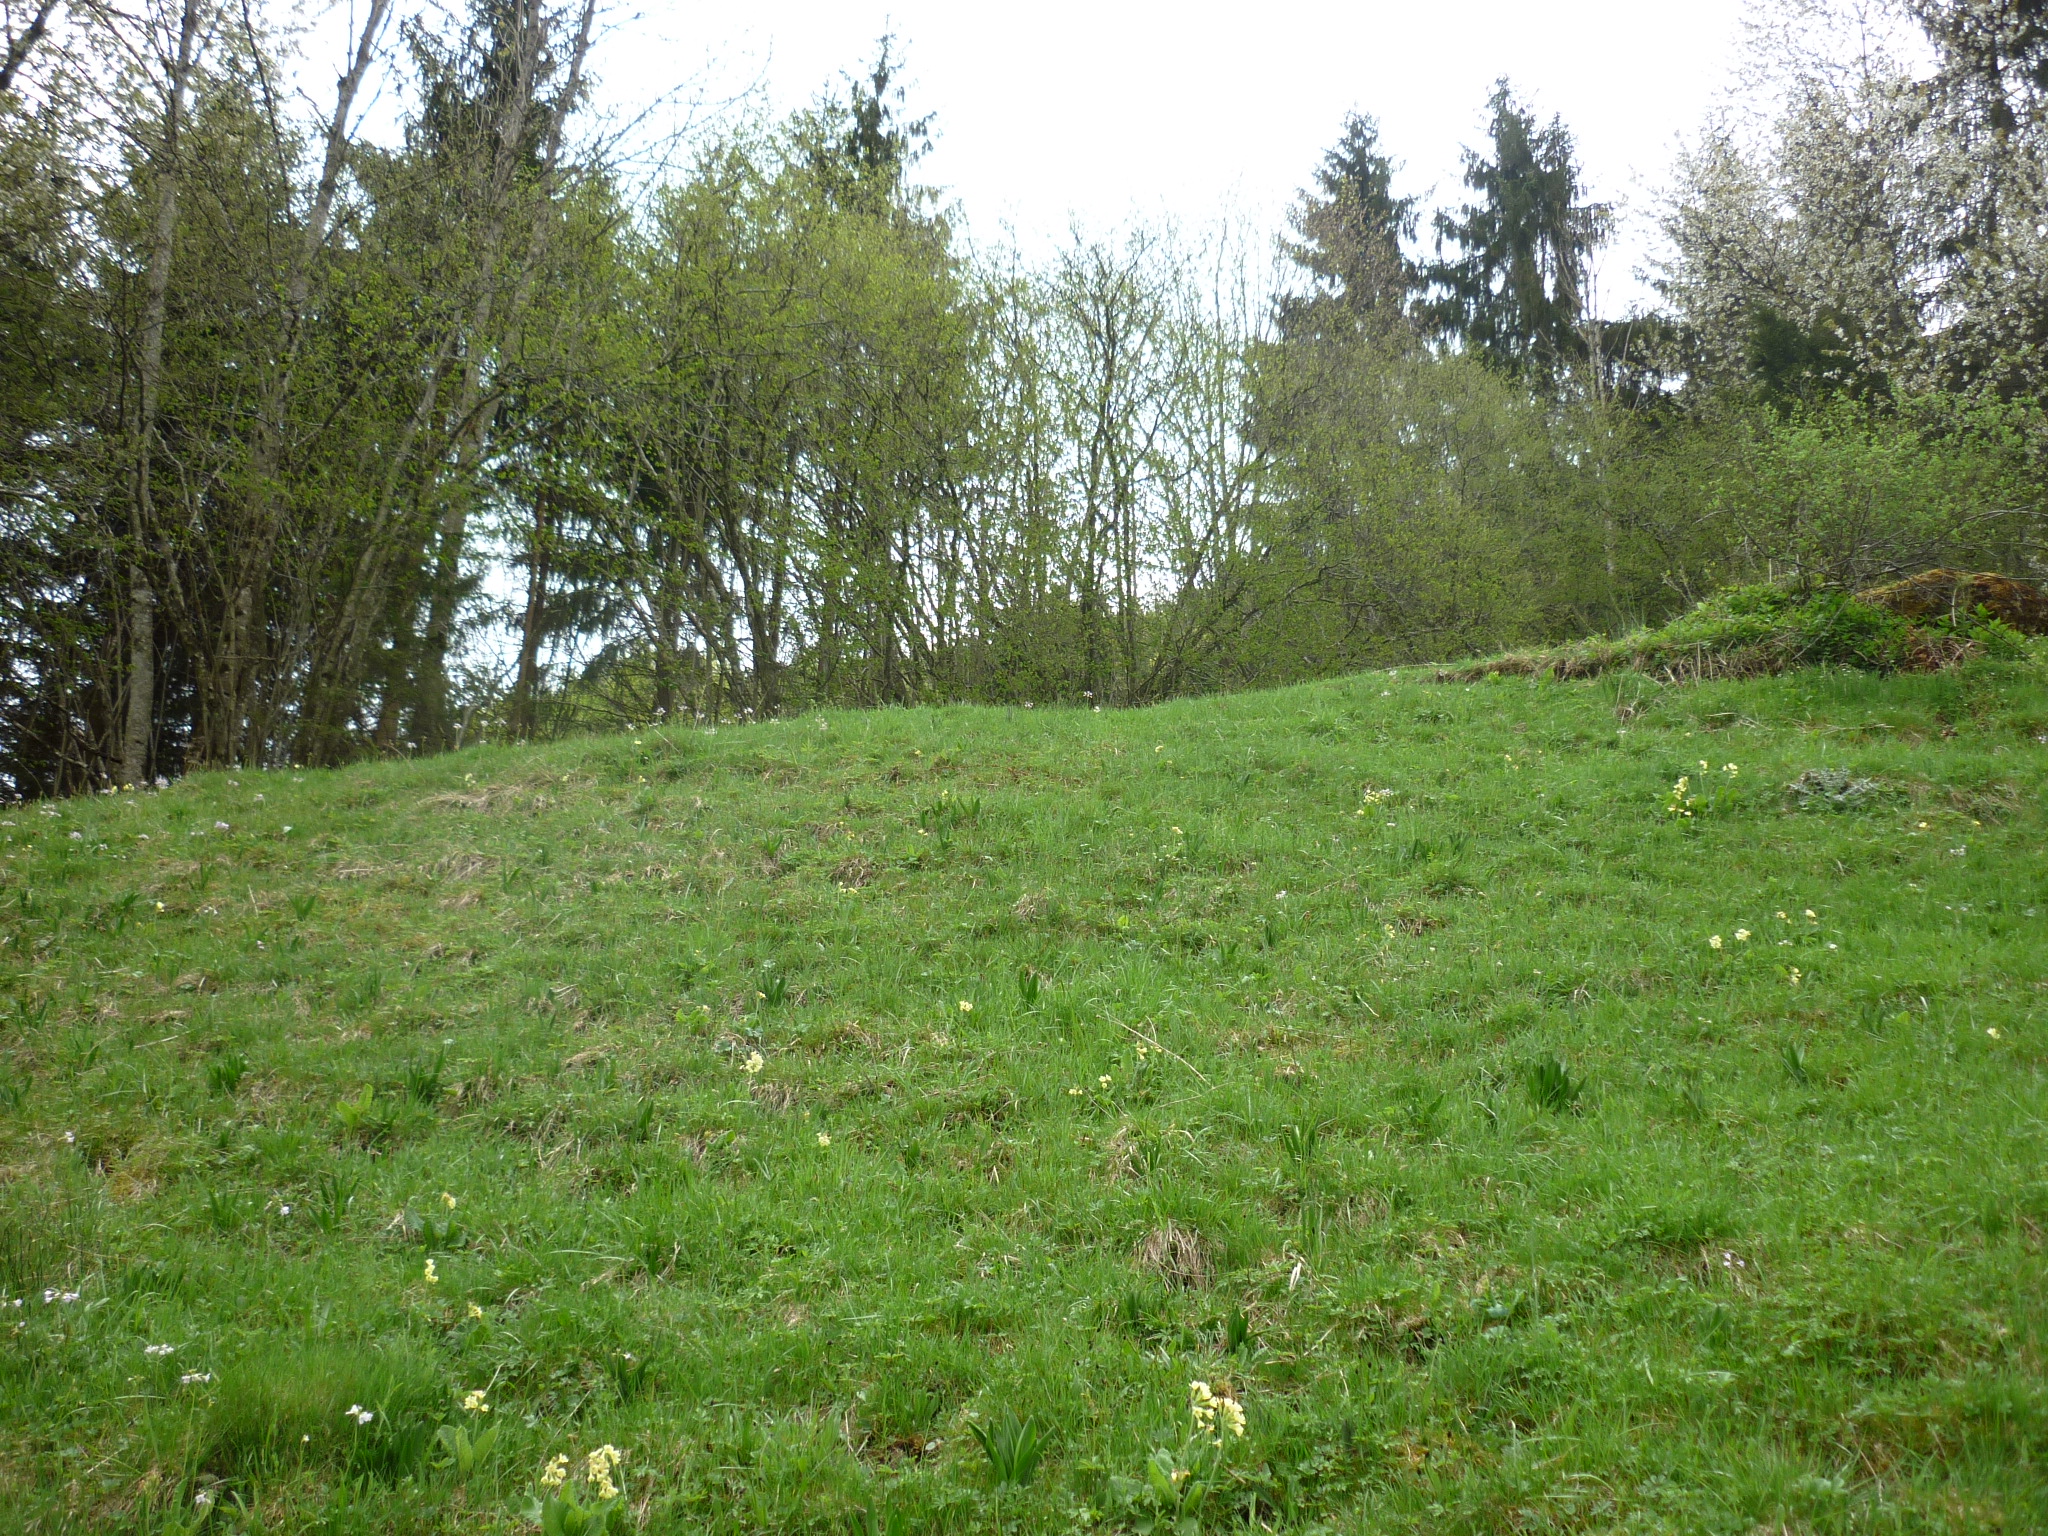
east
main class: Grassland
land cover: Grassland without tree/shrub cover
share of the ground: > 75 %
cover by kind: herbaceous plants 90 %, lichens and mosses 5 %, unconsolidated bare surface 5 %
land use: Agriculture (excluding fallow land and kitchen gardens)
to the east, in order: Grassland without tree/shrub cover; Fences; Spruce dominated mixed woodland; Ditches and canals; Spruce dominated coniferous woodland; Rivers and streams; Spruce dominated mixed woodland; Broadleaved woodland; Shrubland without tree cover
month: May
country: AT
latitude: 47.7142
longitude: 14.5716
